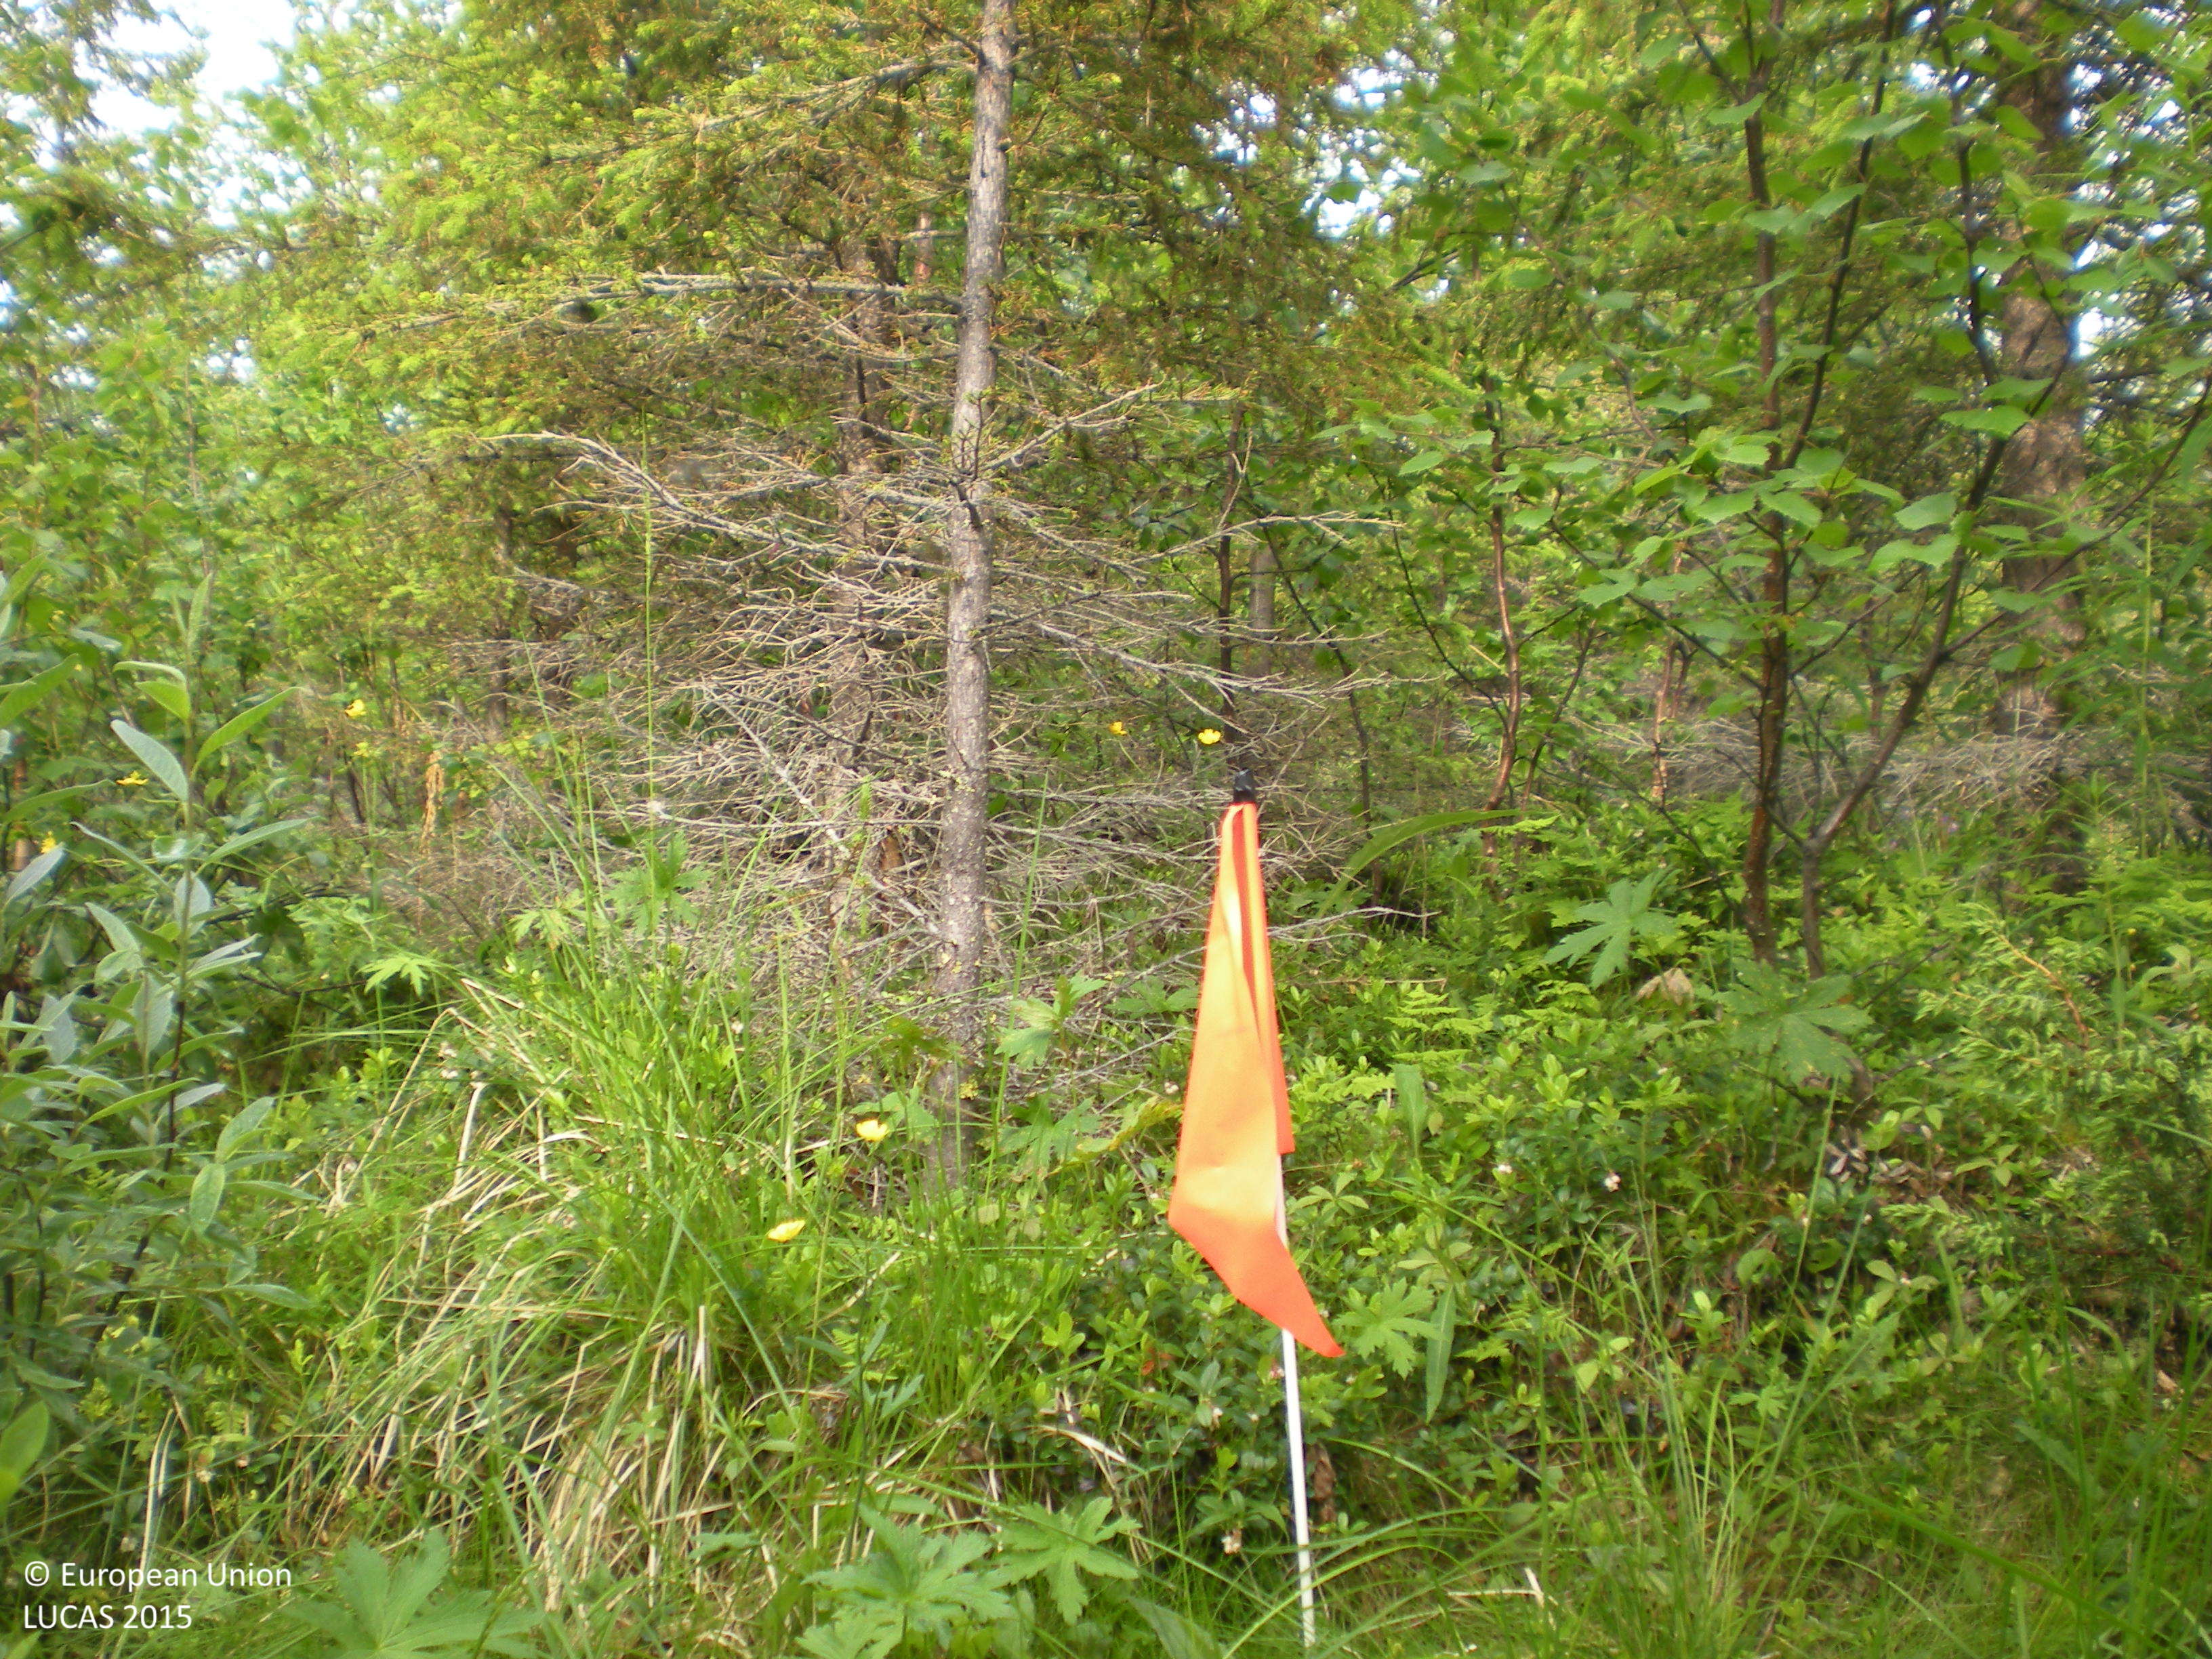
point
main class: Woodland
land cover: Spruce dominated mixed woodland
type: boreal forest
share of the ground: > 75 %
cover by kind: coniferous forest trees 45 %, broadleaved forest trees 40 %, herbaceous plants 10 %, shrubs 5 %
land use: Forestry
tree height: < 5 m
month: July
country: SE
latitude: 65.9598
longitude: 17.1943
